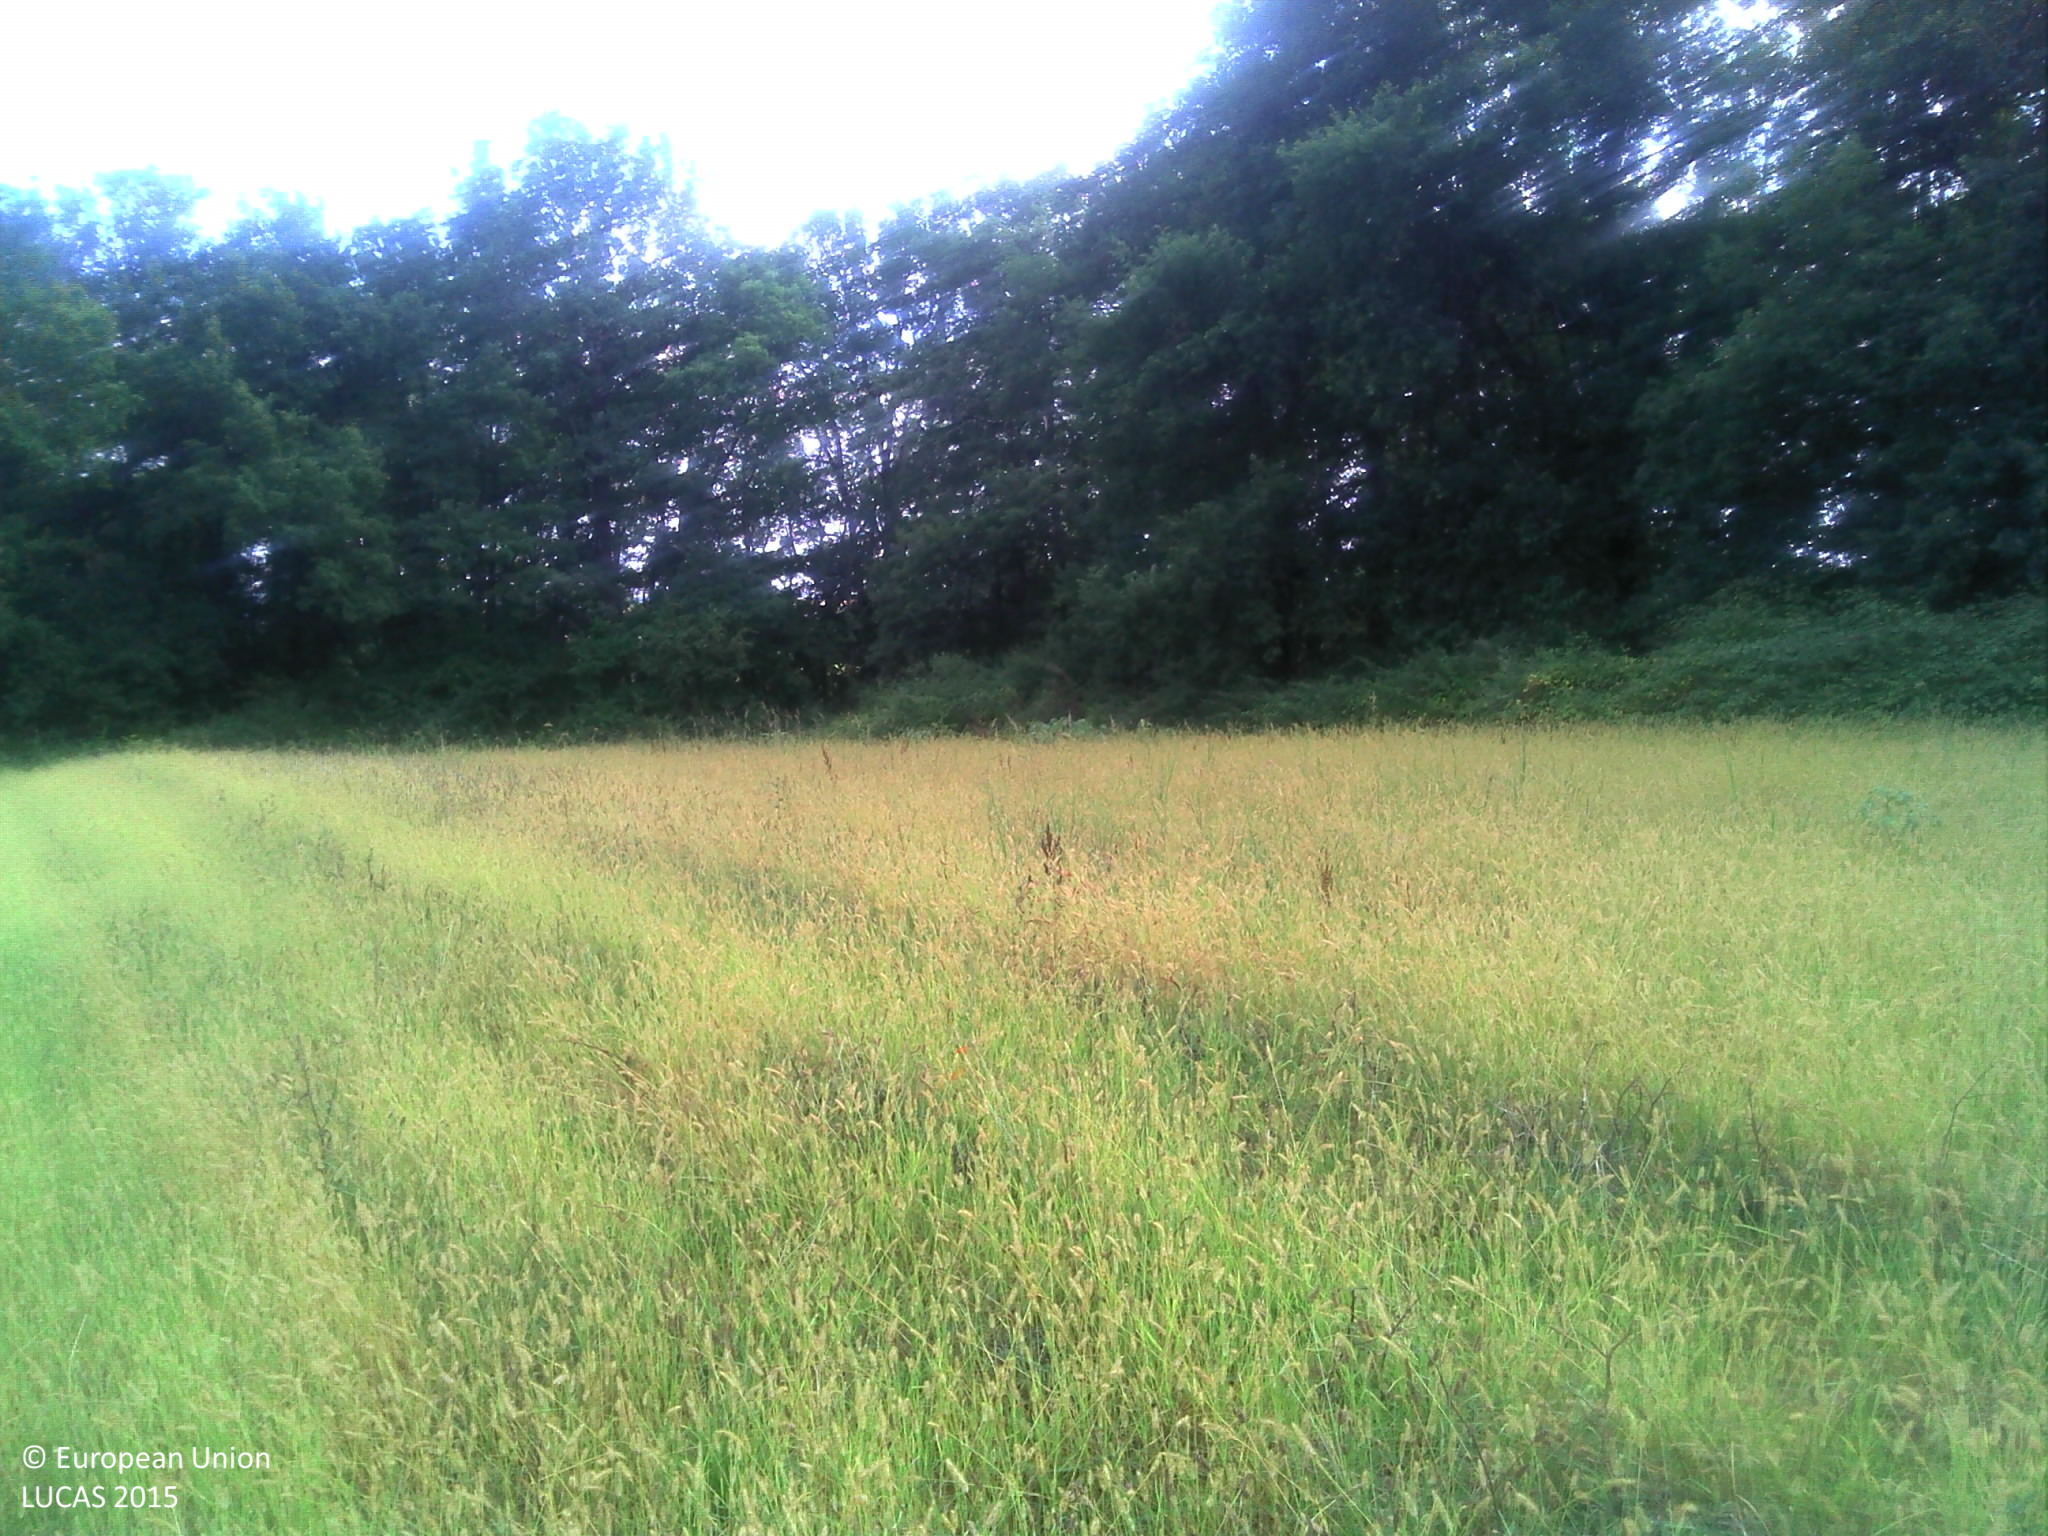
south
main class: Grassland
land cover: Spontaneously vegetated surfaces
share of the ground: > 75 %
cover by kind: herbaceous plants 100 %
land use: Fallow land
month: July
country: FR
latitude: 44.0521
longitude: 0.6217
